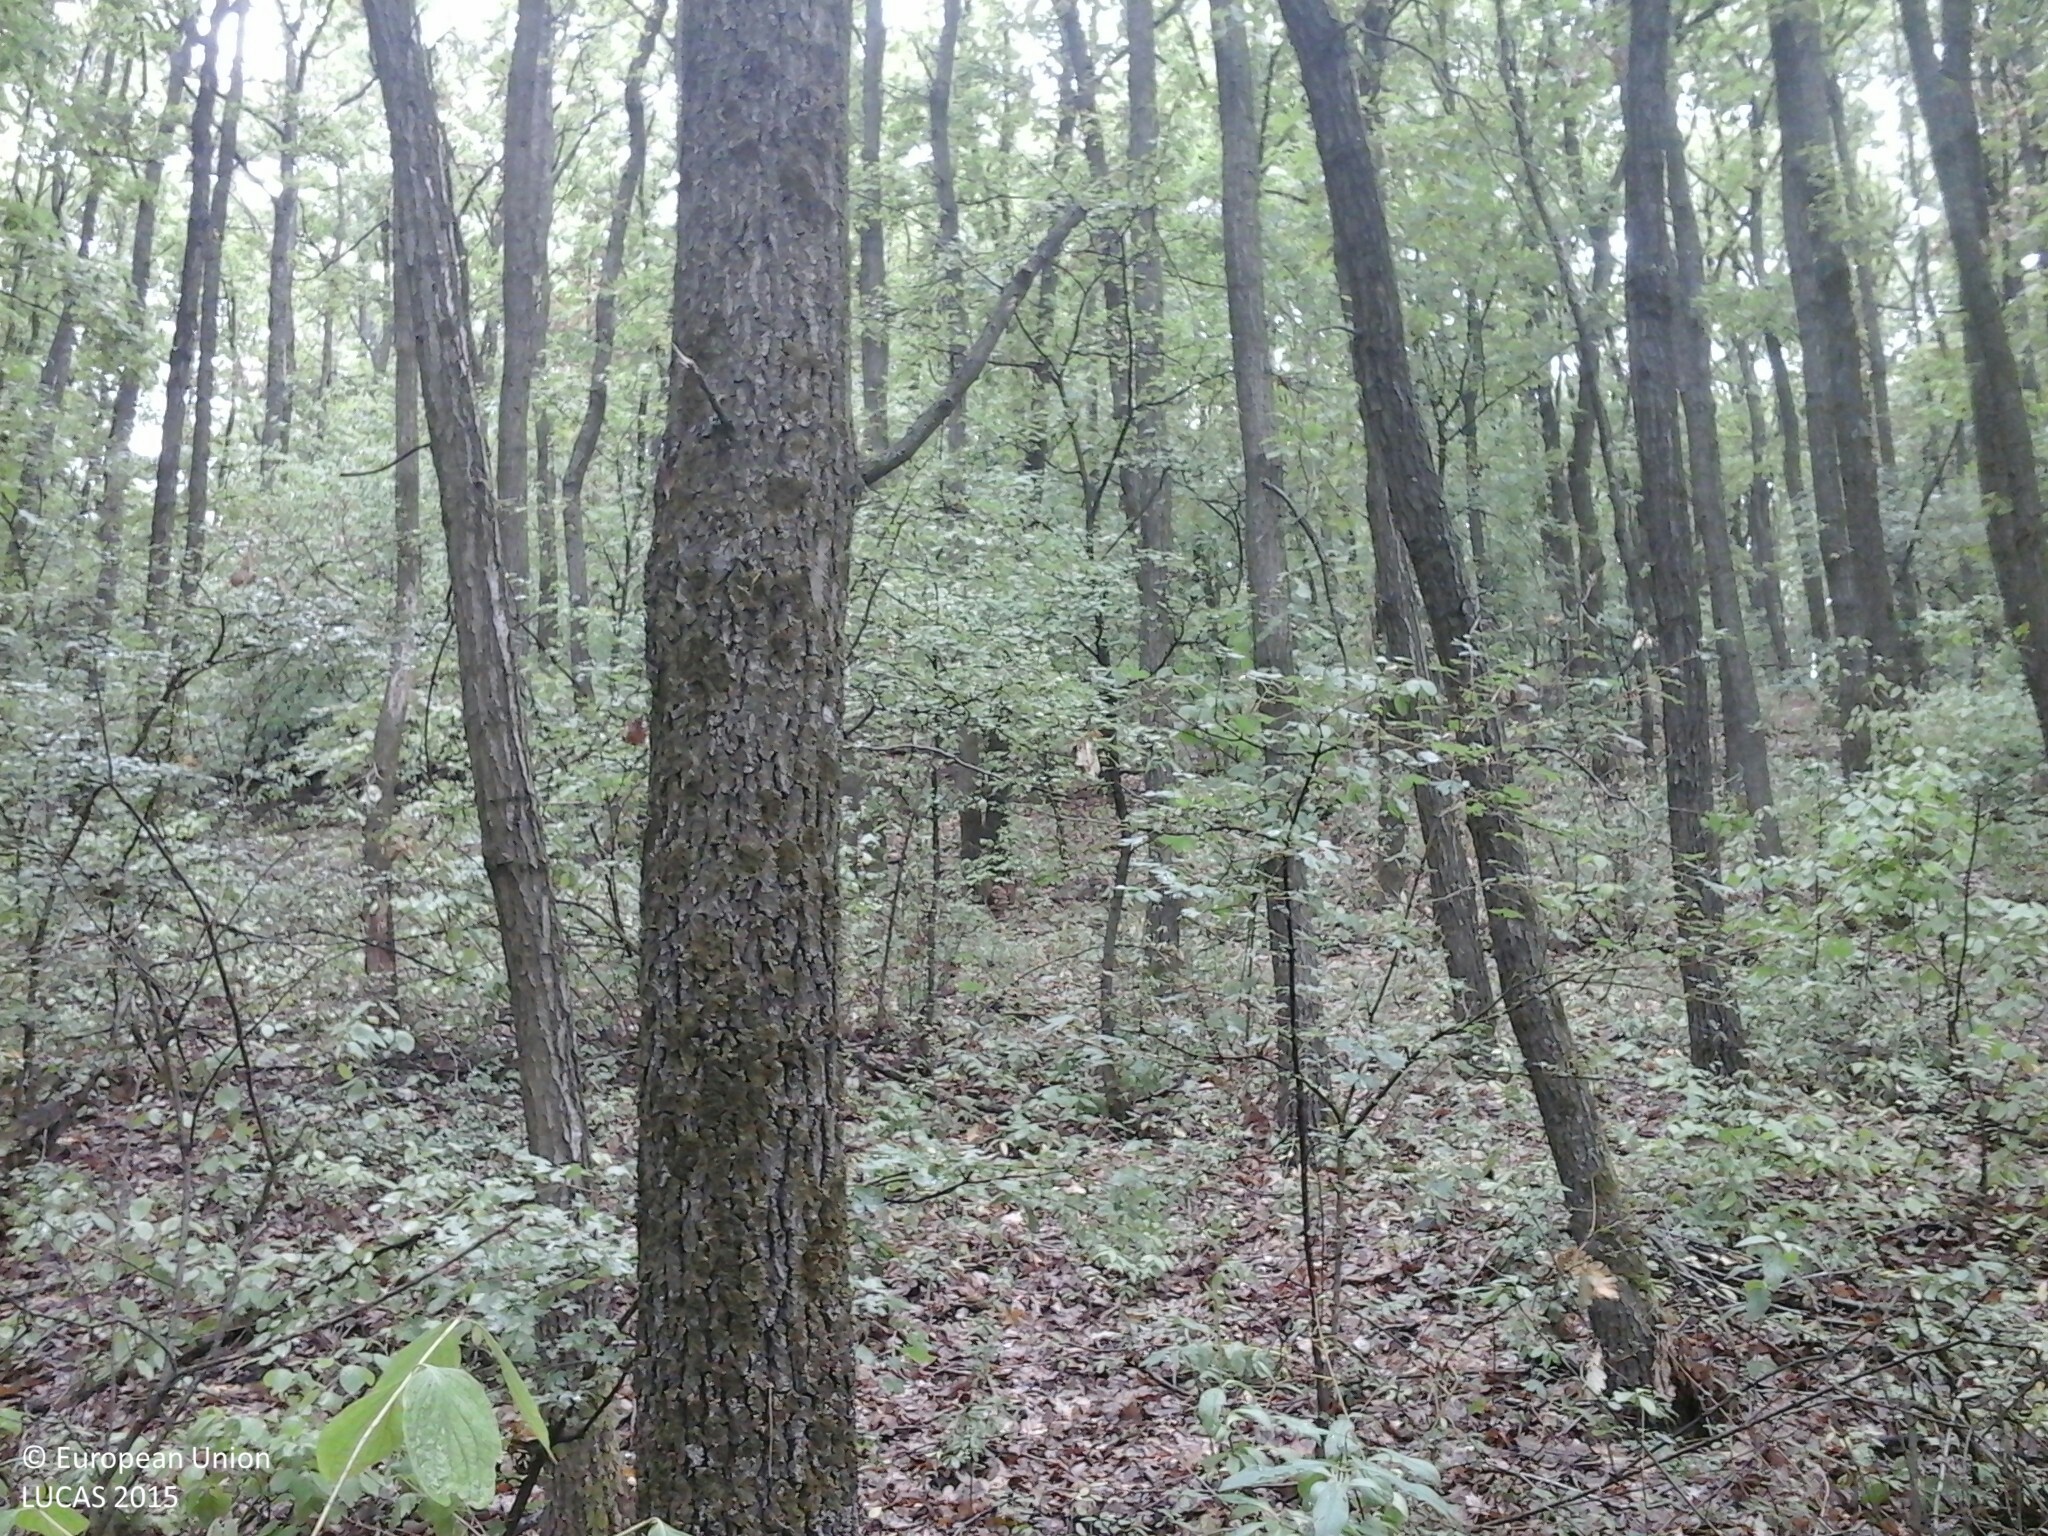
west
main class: Woodland
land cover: Broadleaved woodland
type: acidophilous oak and oak-birch forest
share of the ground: > 75 %
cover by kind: broadleaved forest trees 85 %, shrubs 15 %
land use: Forestry
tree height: > 5 m
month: July
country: HU
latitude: 47.9700
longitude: 20.3589
